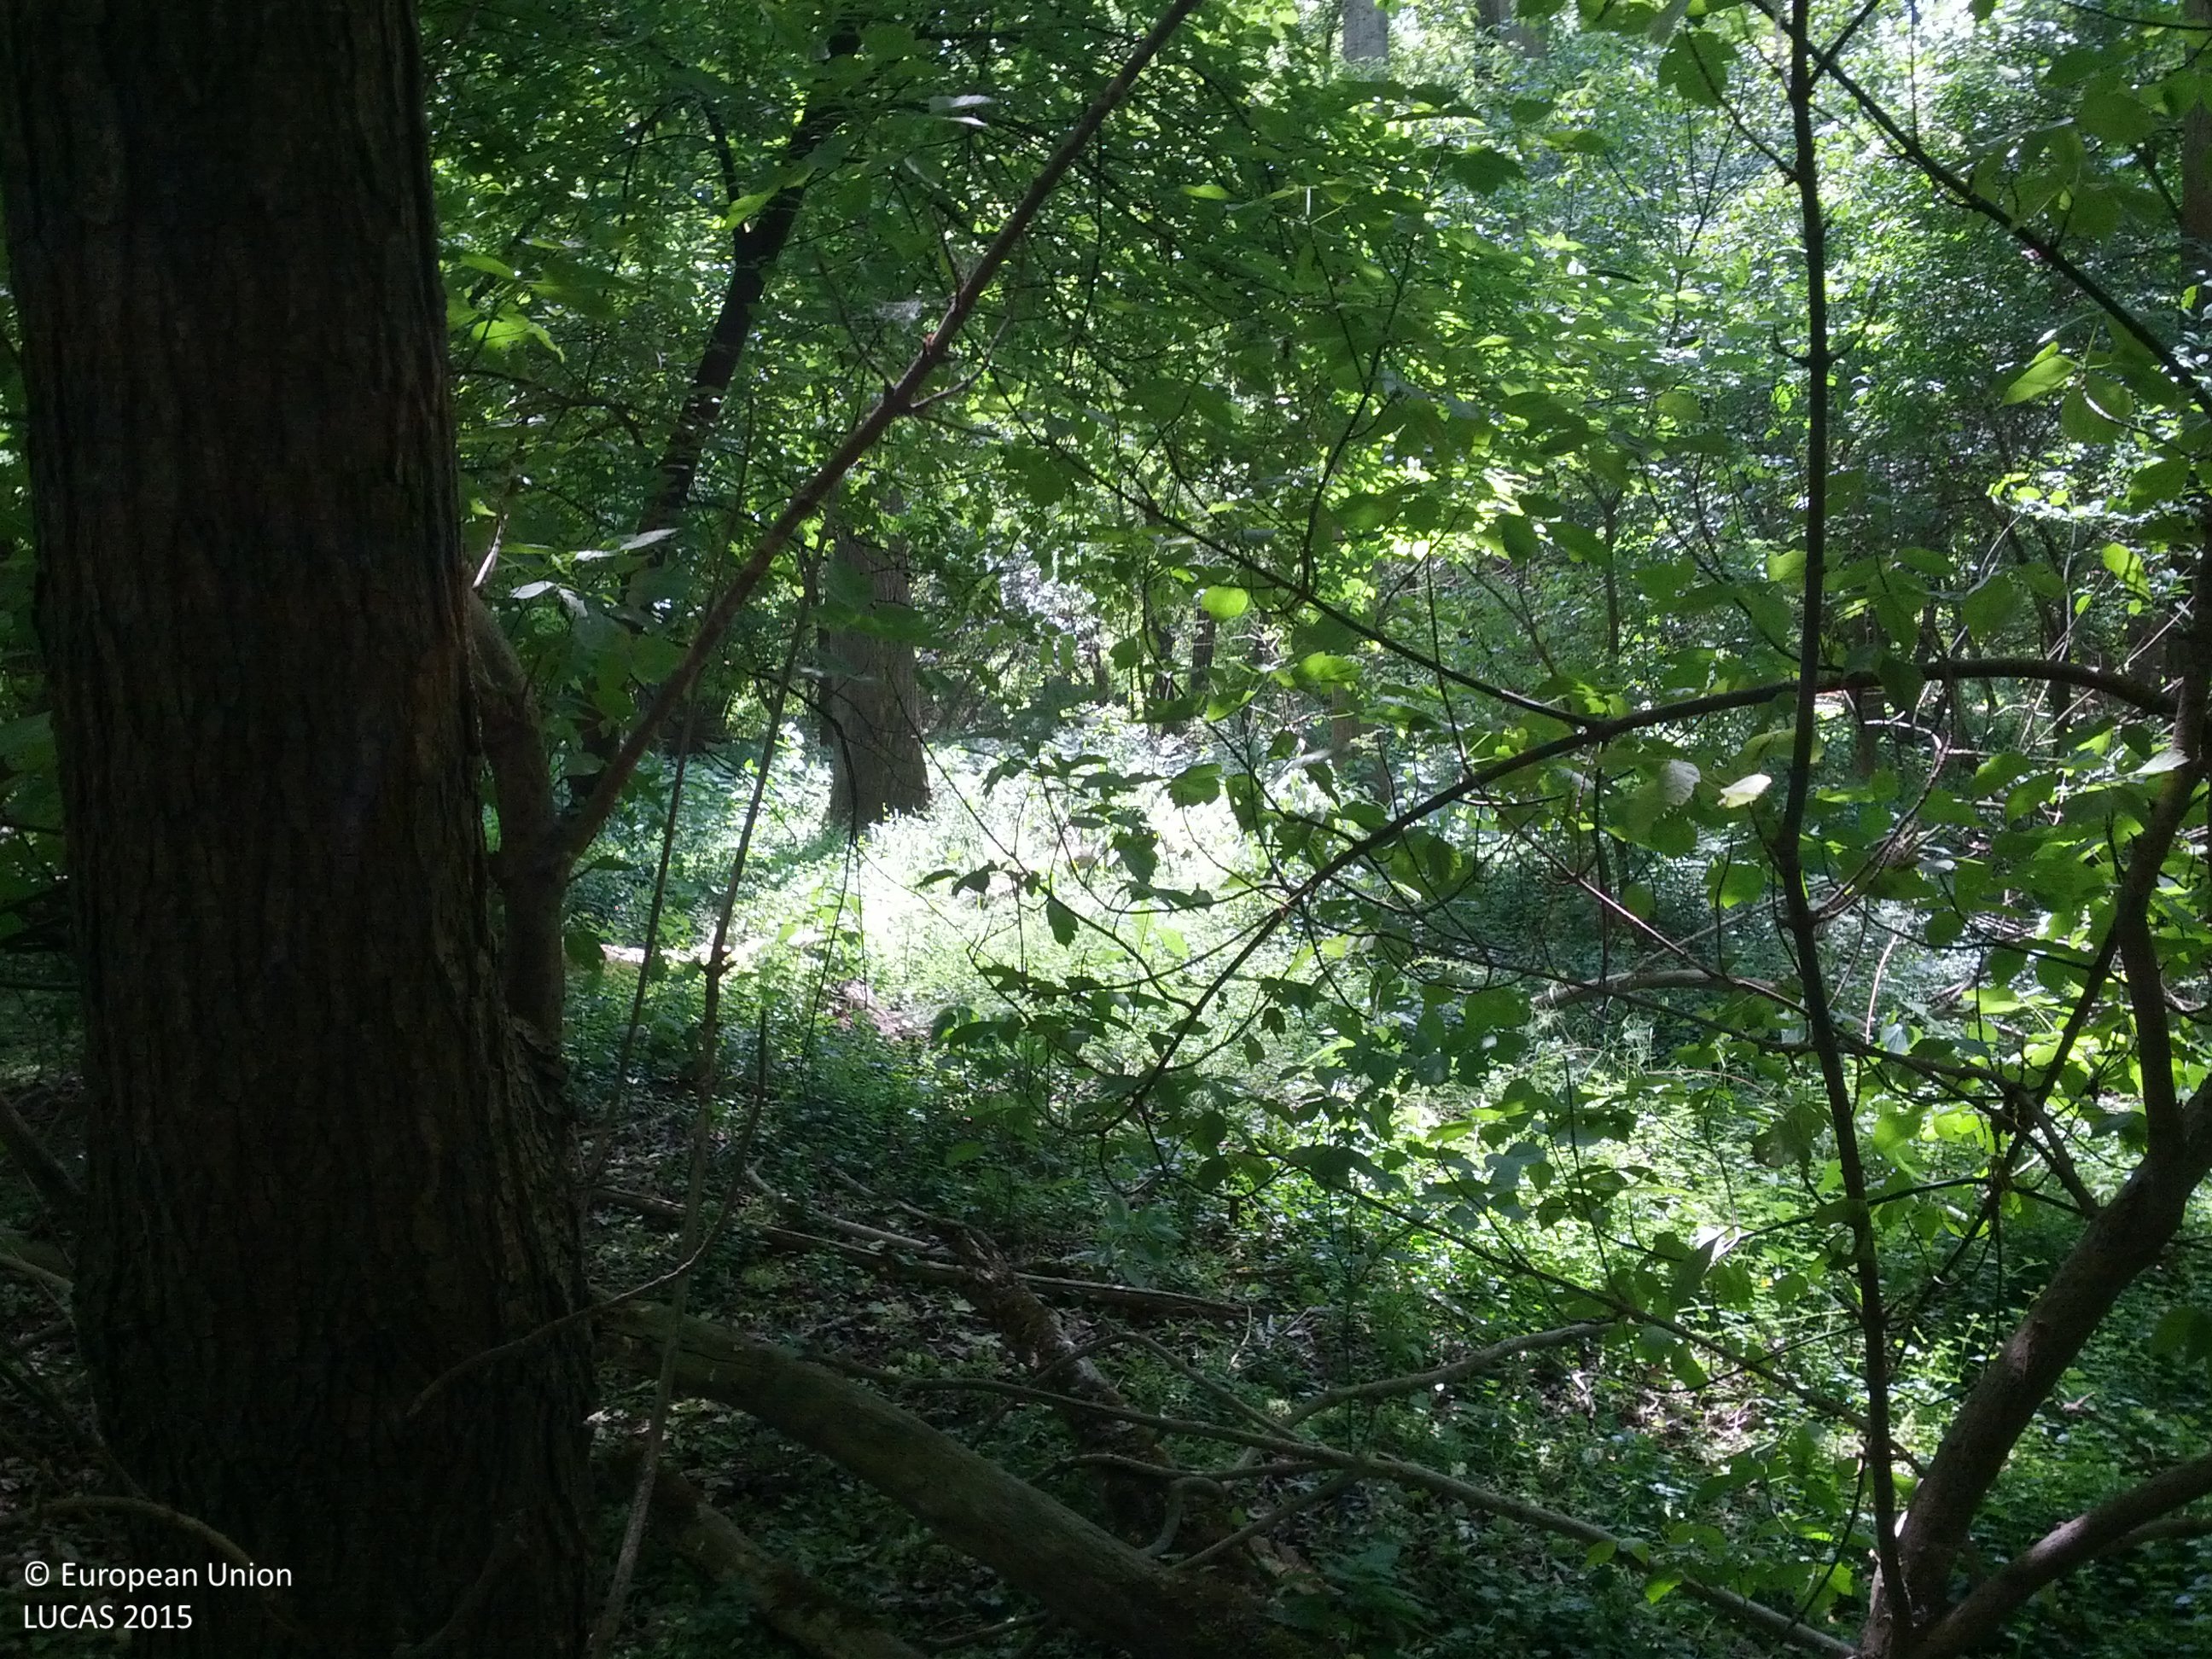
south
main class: Woodland
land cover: Broadleaved woodland
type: floodplain forest
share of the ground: > 75 %
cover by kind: broadleaved forest trees 90 %, shrubs 5 %, herbaceous plants 5 %
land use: Amenities, museums, leisure
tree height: > 5 m
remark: Temporary flooded
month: May
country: AT
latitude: 48.1370
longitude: 16.5499
